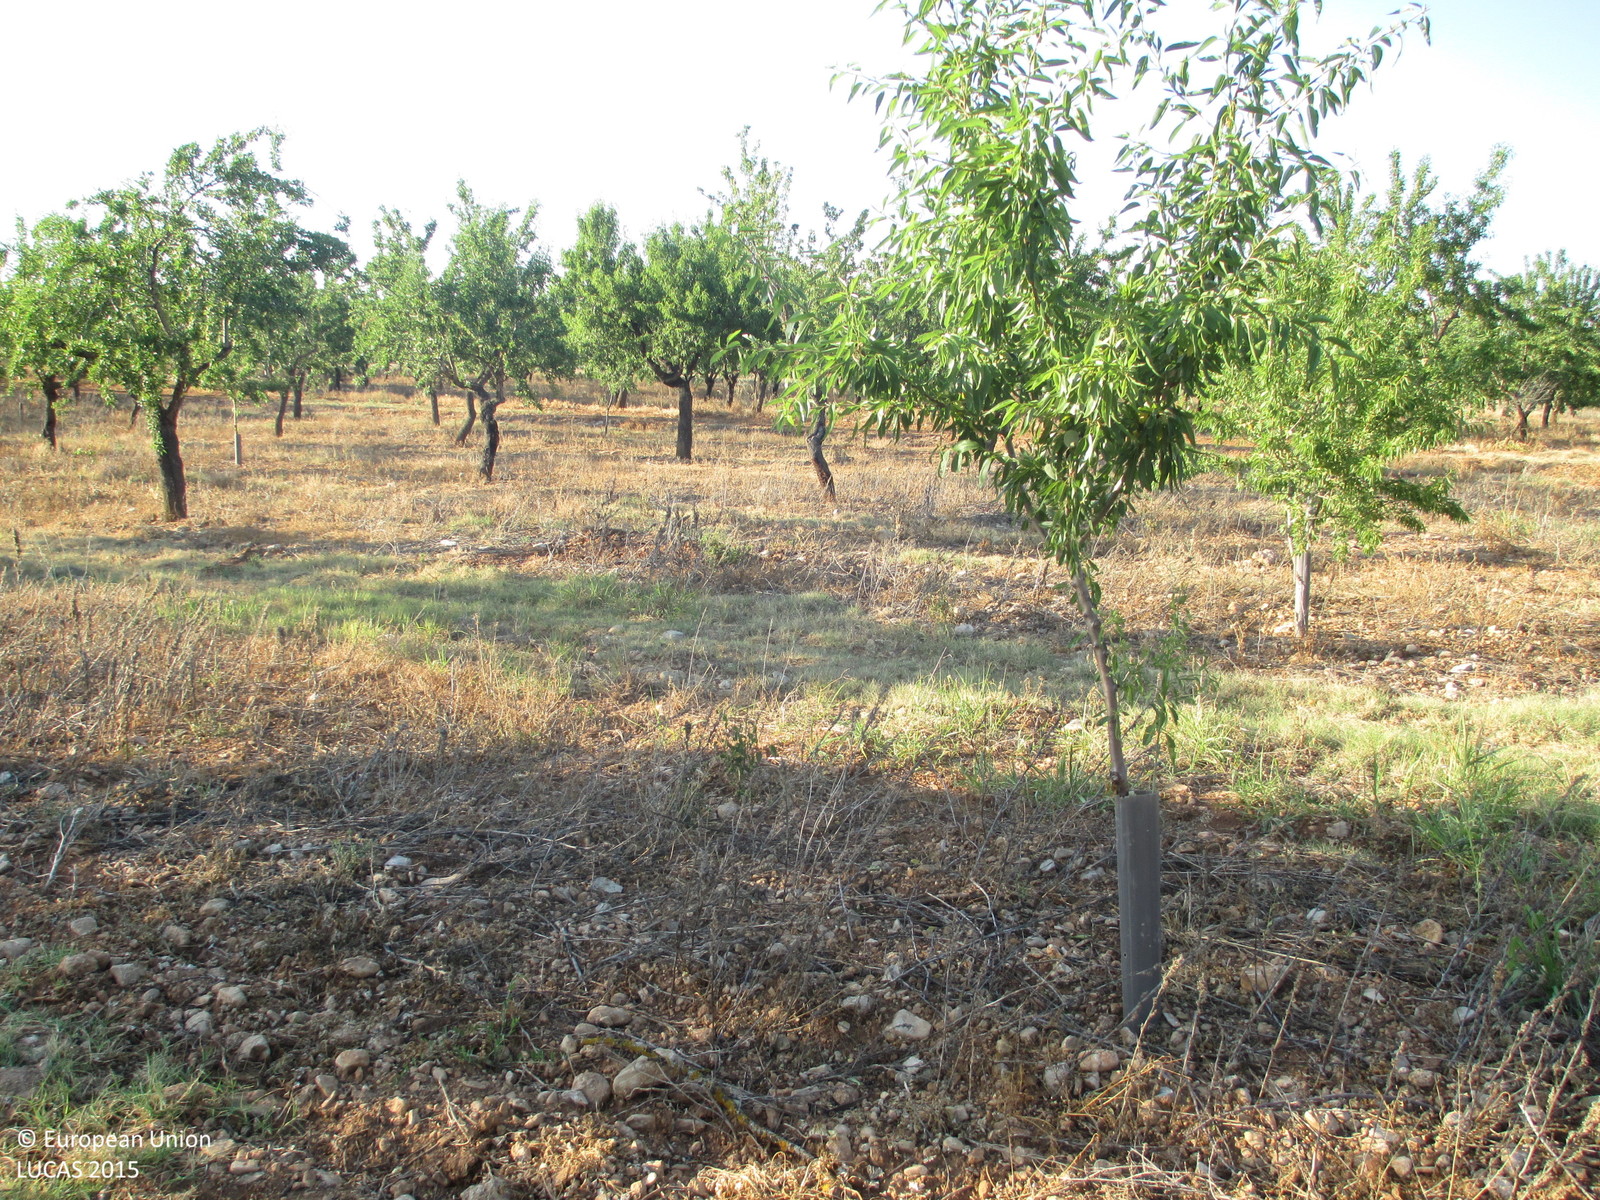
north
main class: Cropland
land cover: Nuts trees
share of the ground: > 75 %
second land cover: Other bare soil
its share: > 75 %
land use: Agriculture (excluding fallow land and kitchen gardens)
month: June
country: ES
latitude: 42.1169
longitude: -0.0467
